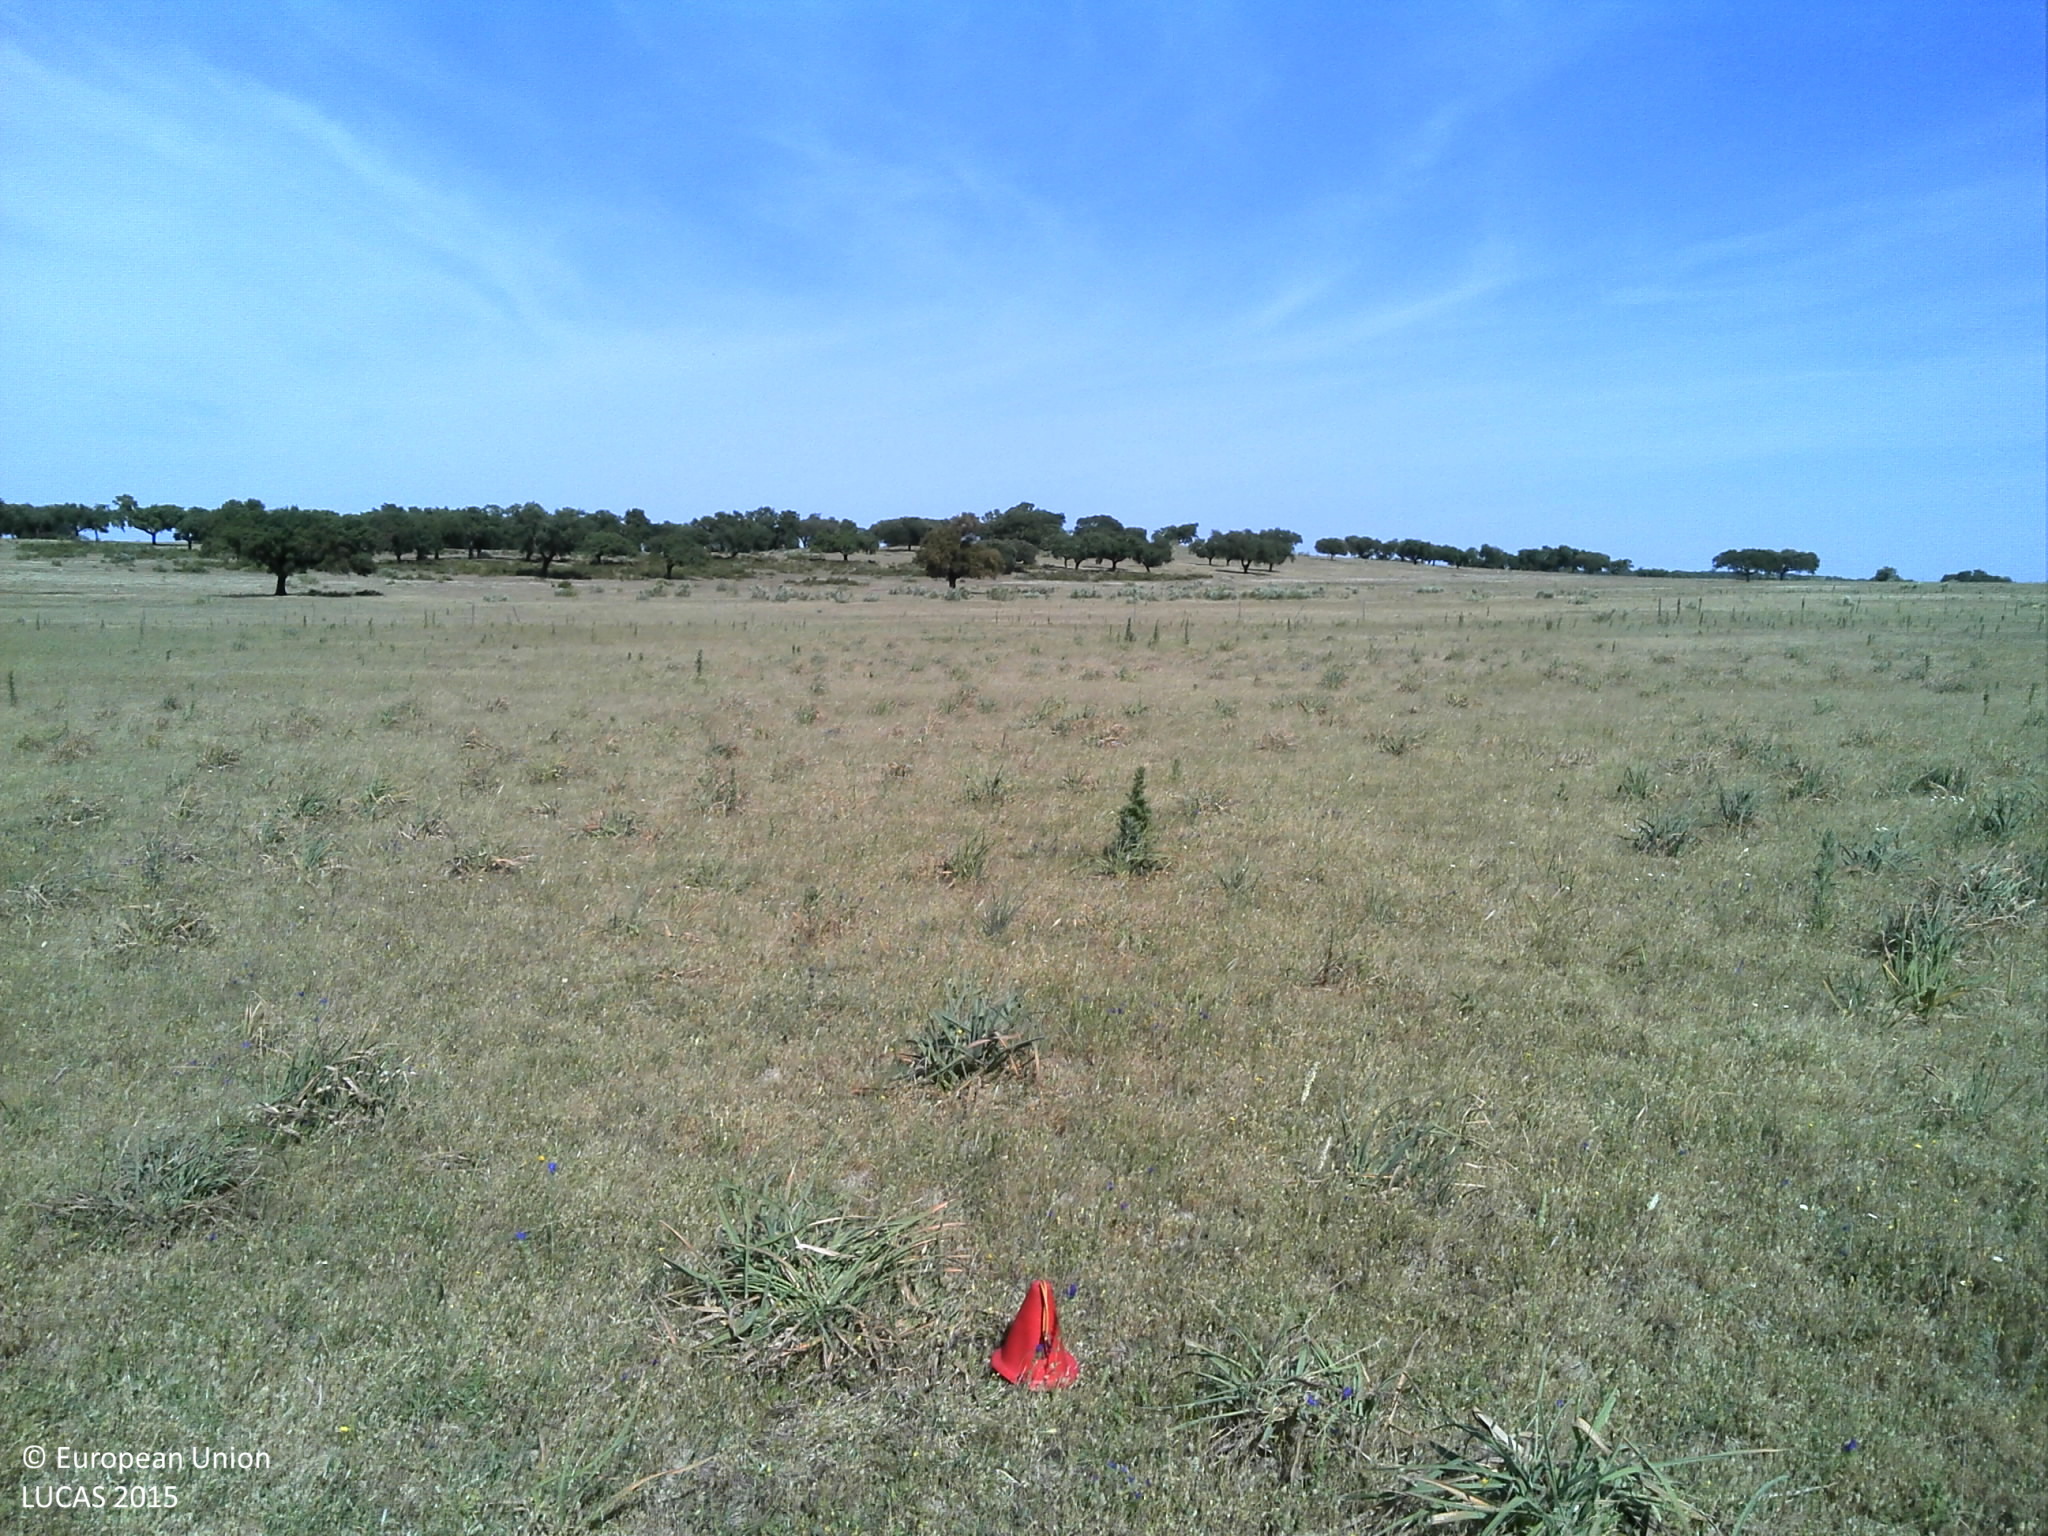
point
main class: Grassland
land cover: Grassland without tree/shrub cover
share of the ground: 50 - 75 %
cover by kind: herbaceous plants 85 %, unconsolidated bare surface 15 %
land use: Agriculture (excluding fallow land and kitchen gardens)
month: May
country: PT
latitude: 39.1826
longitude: -7.5814
